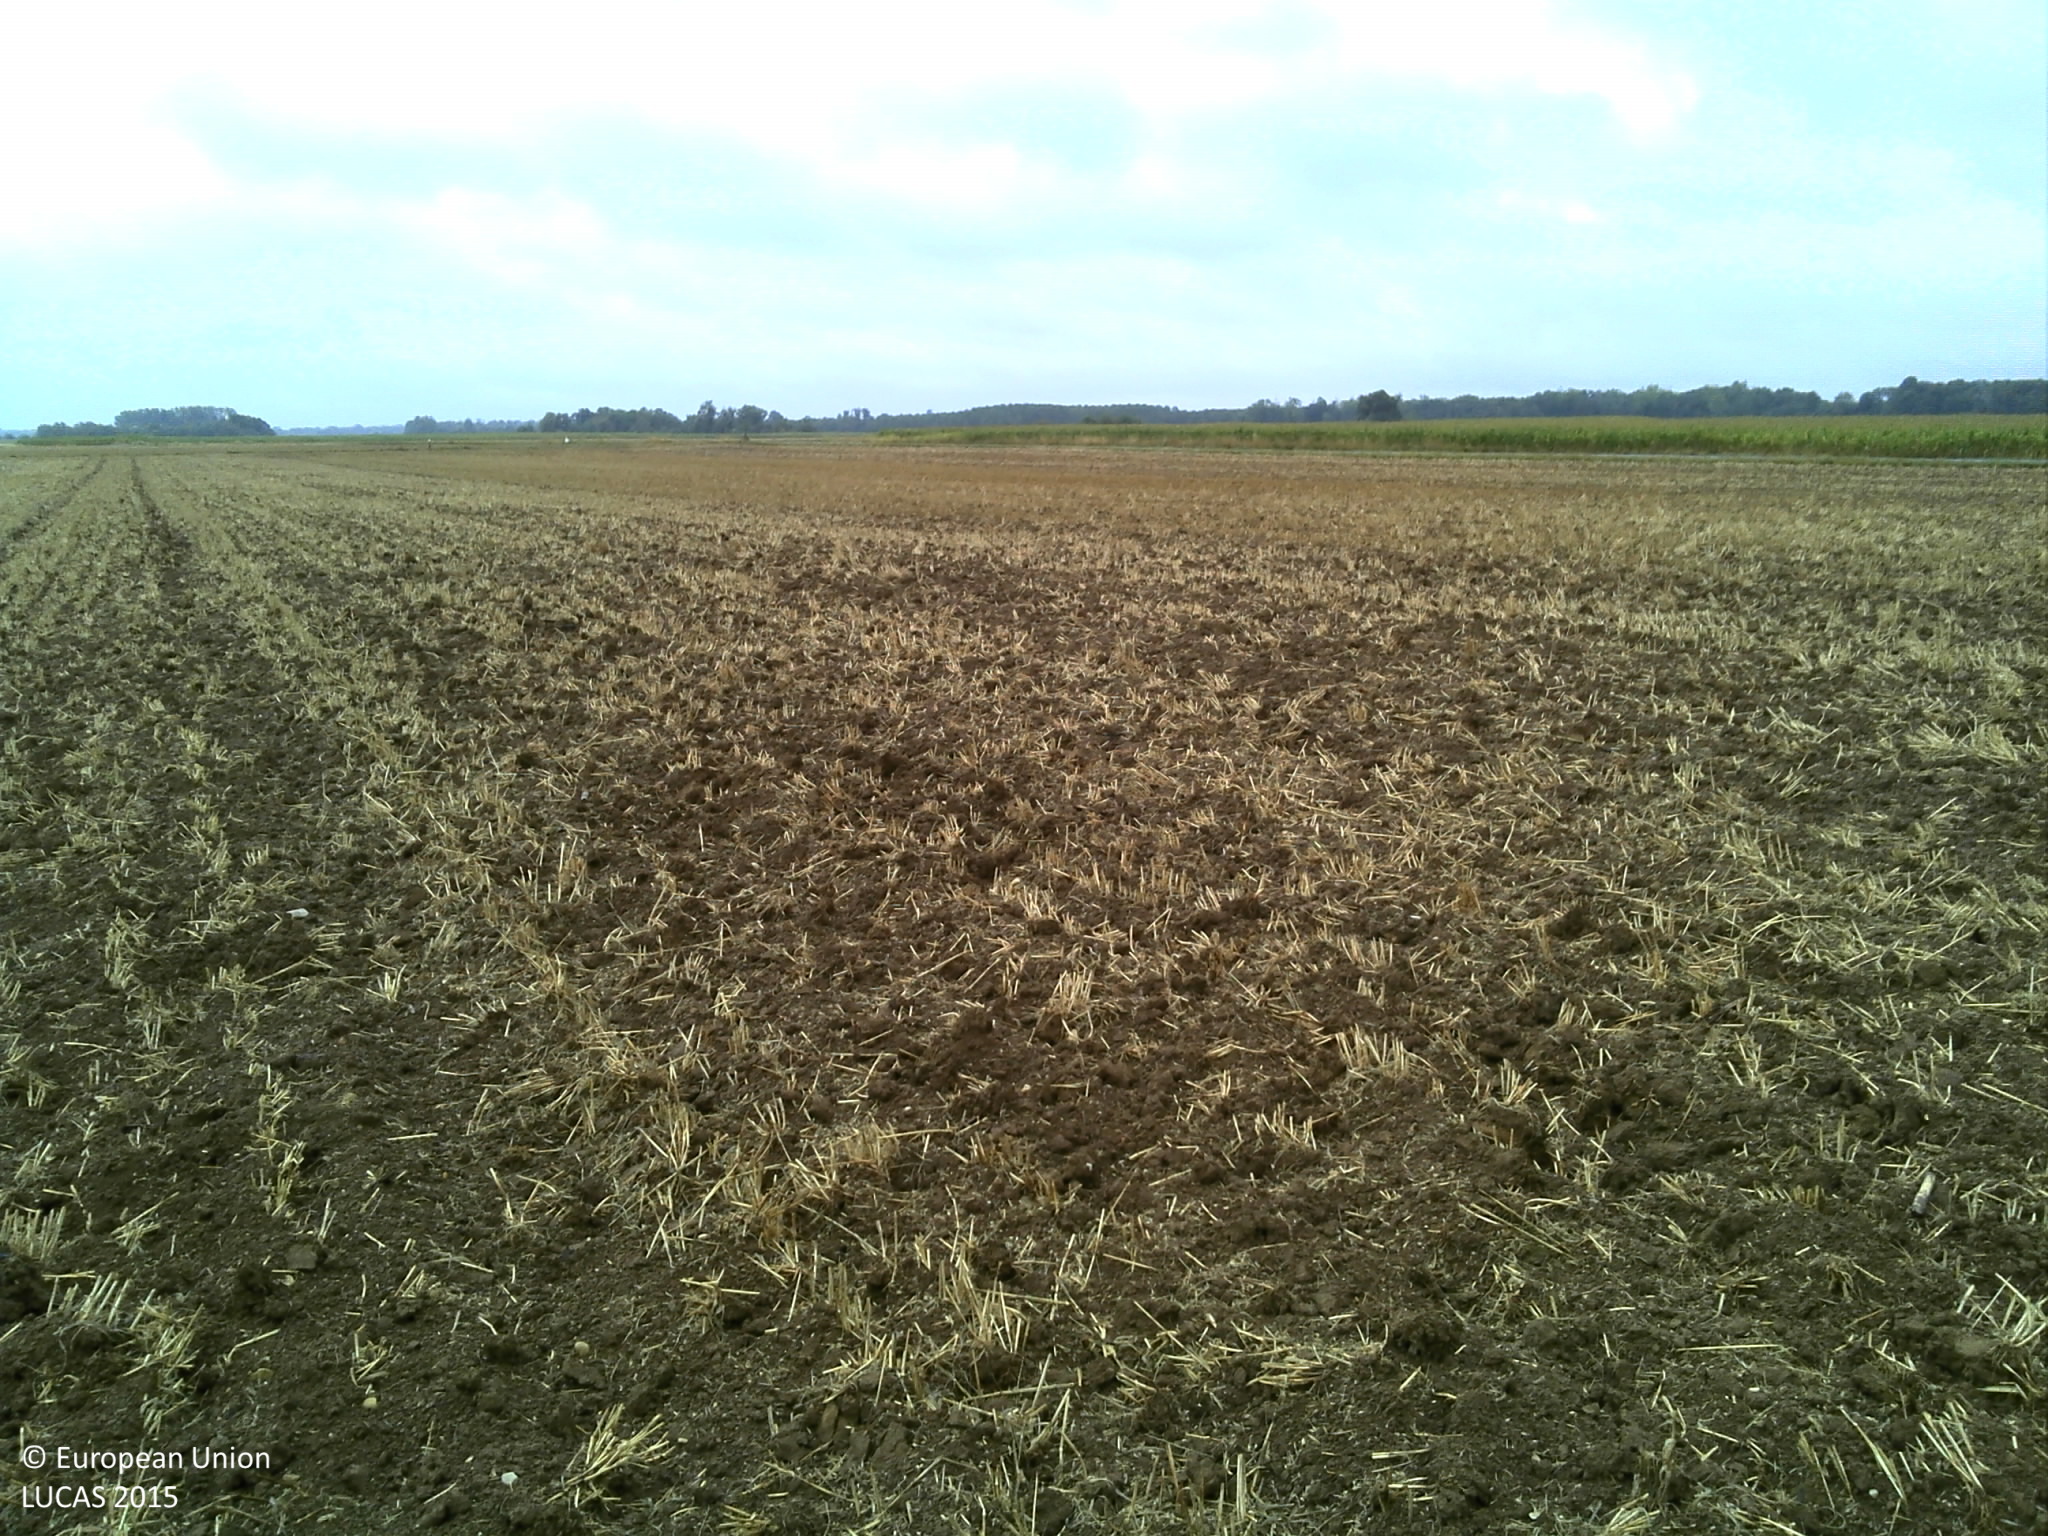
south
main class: Cropland
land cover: Common wheat
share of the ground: > 75 %
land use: Agriculture (excluding fallow land and kitchen gardens)
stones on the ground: < 10 %
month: August
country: FR
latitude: 48.6802
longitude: 4.8503
